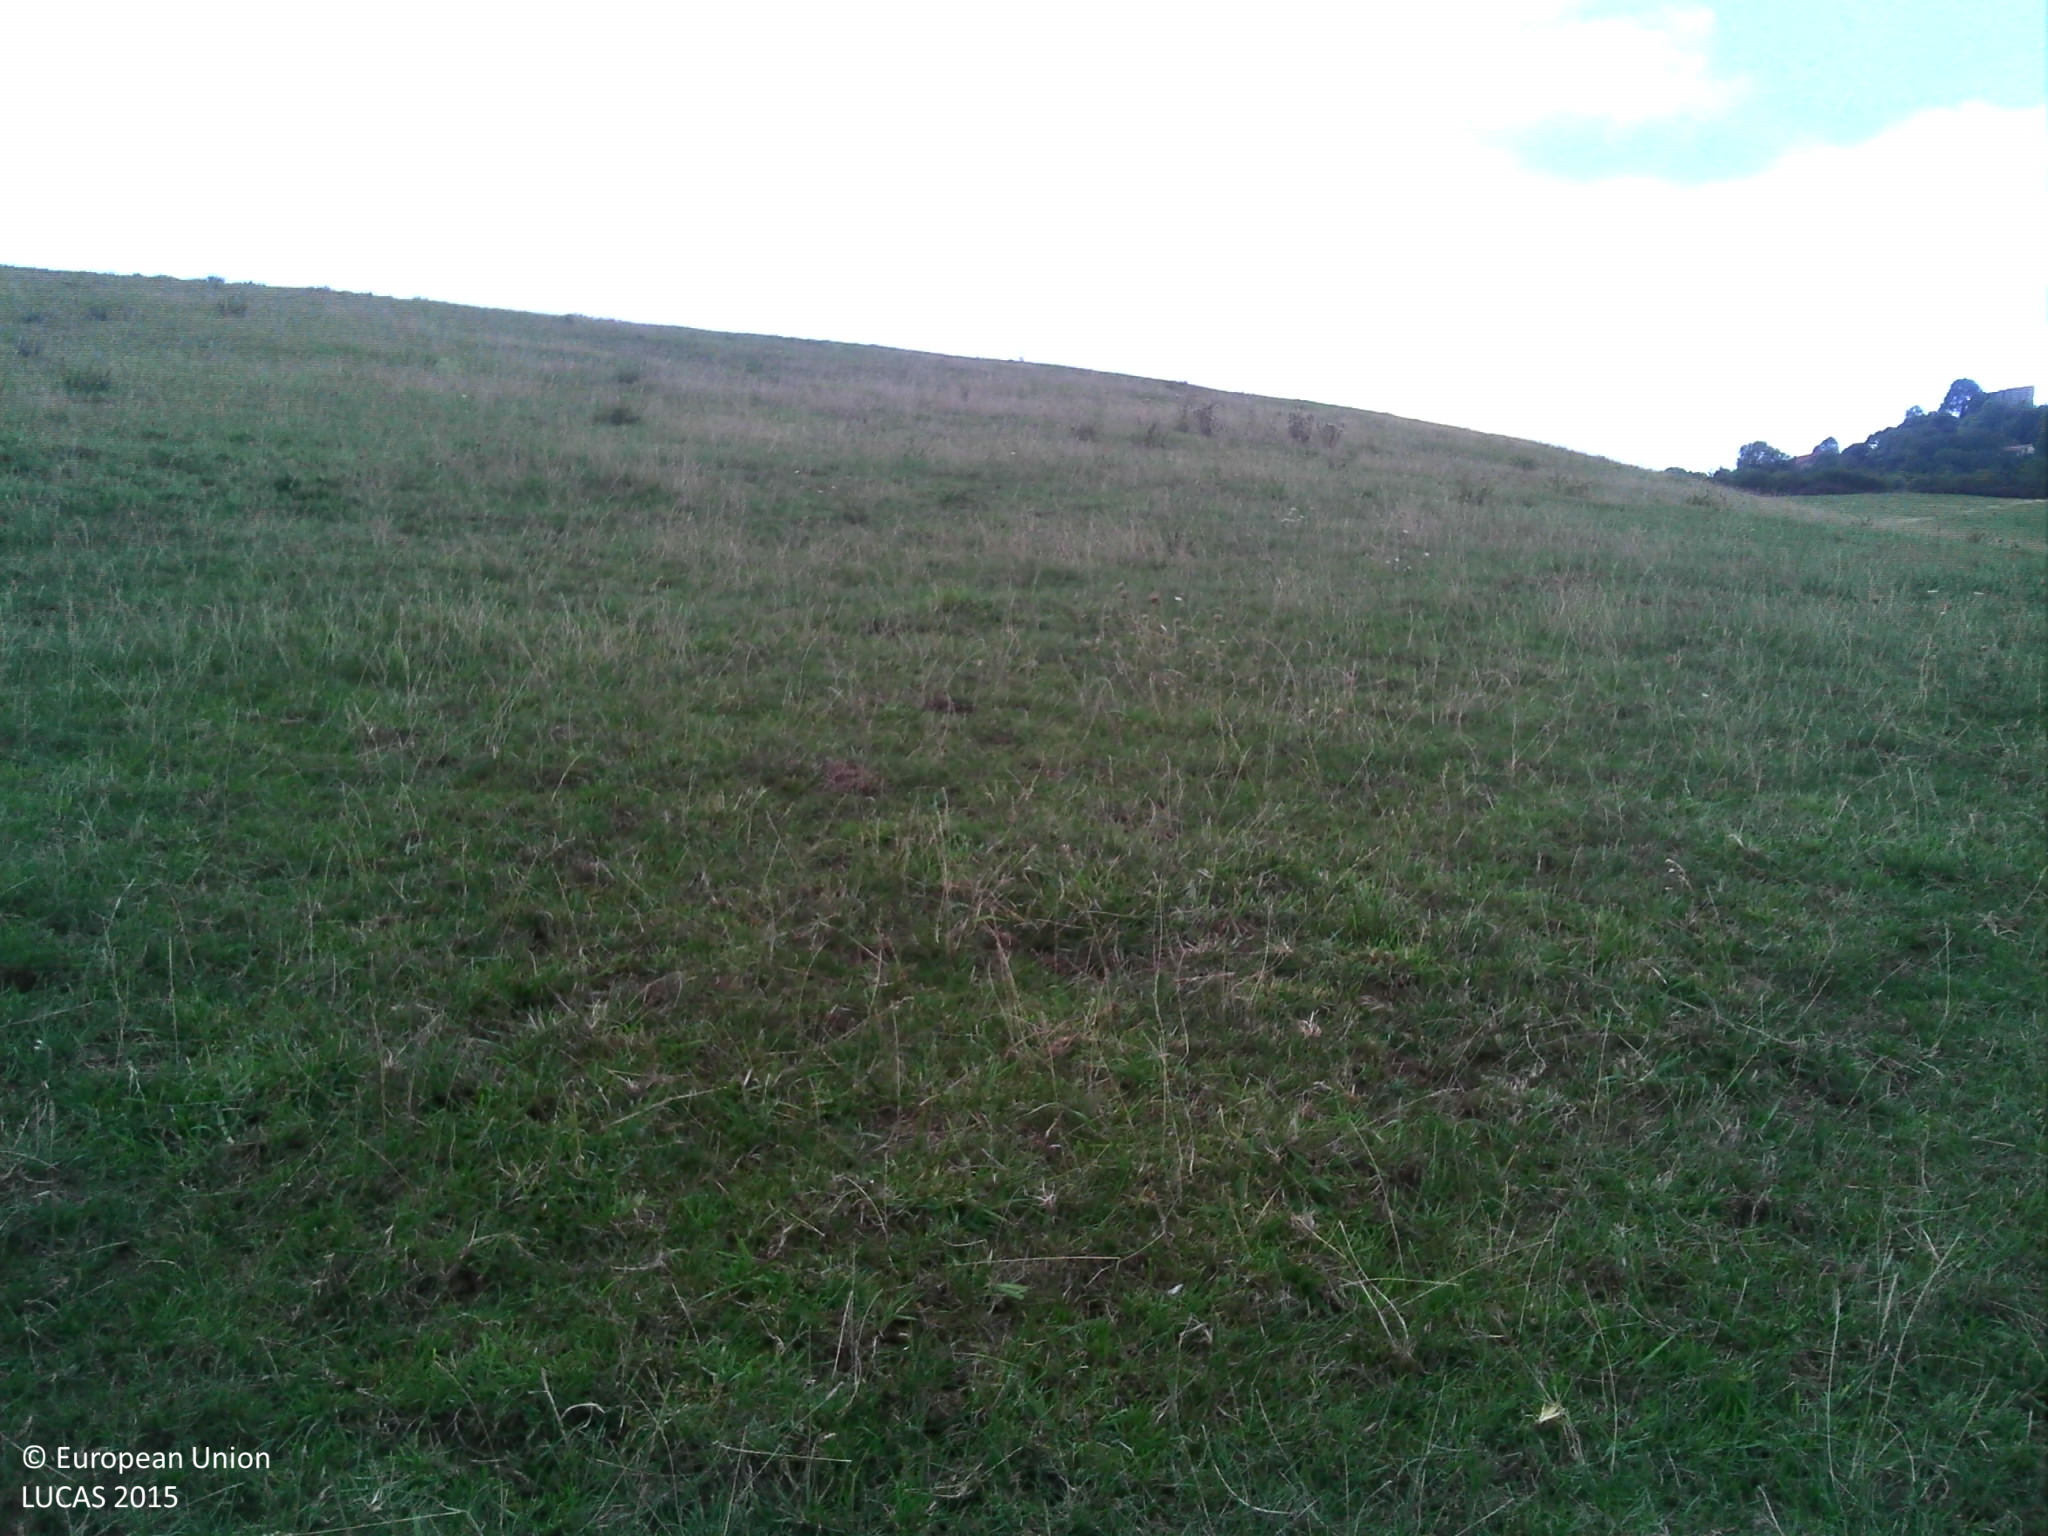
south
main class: Grassland
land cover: Grassland without tree/shrub cover
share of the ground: > 75 %
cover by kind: herbaceous plants 95 %, unconsolidated bare surface 5 %
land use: Agriculture (excluding fallow land and kitchen gardens)
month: September
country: FR
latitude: 48.9106
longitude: 6.0838
